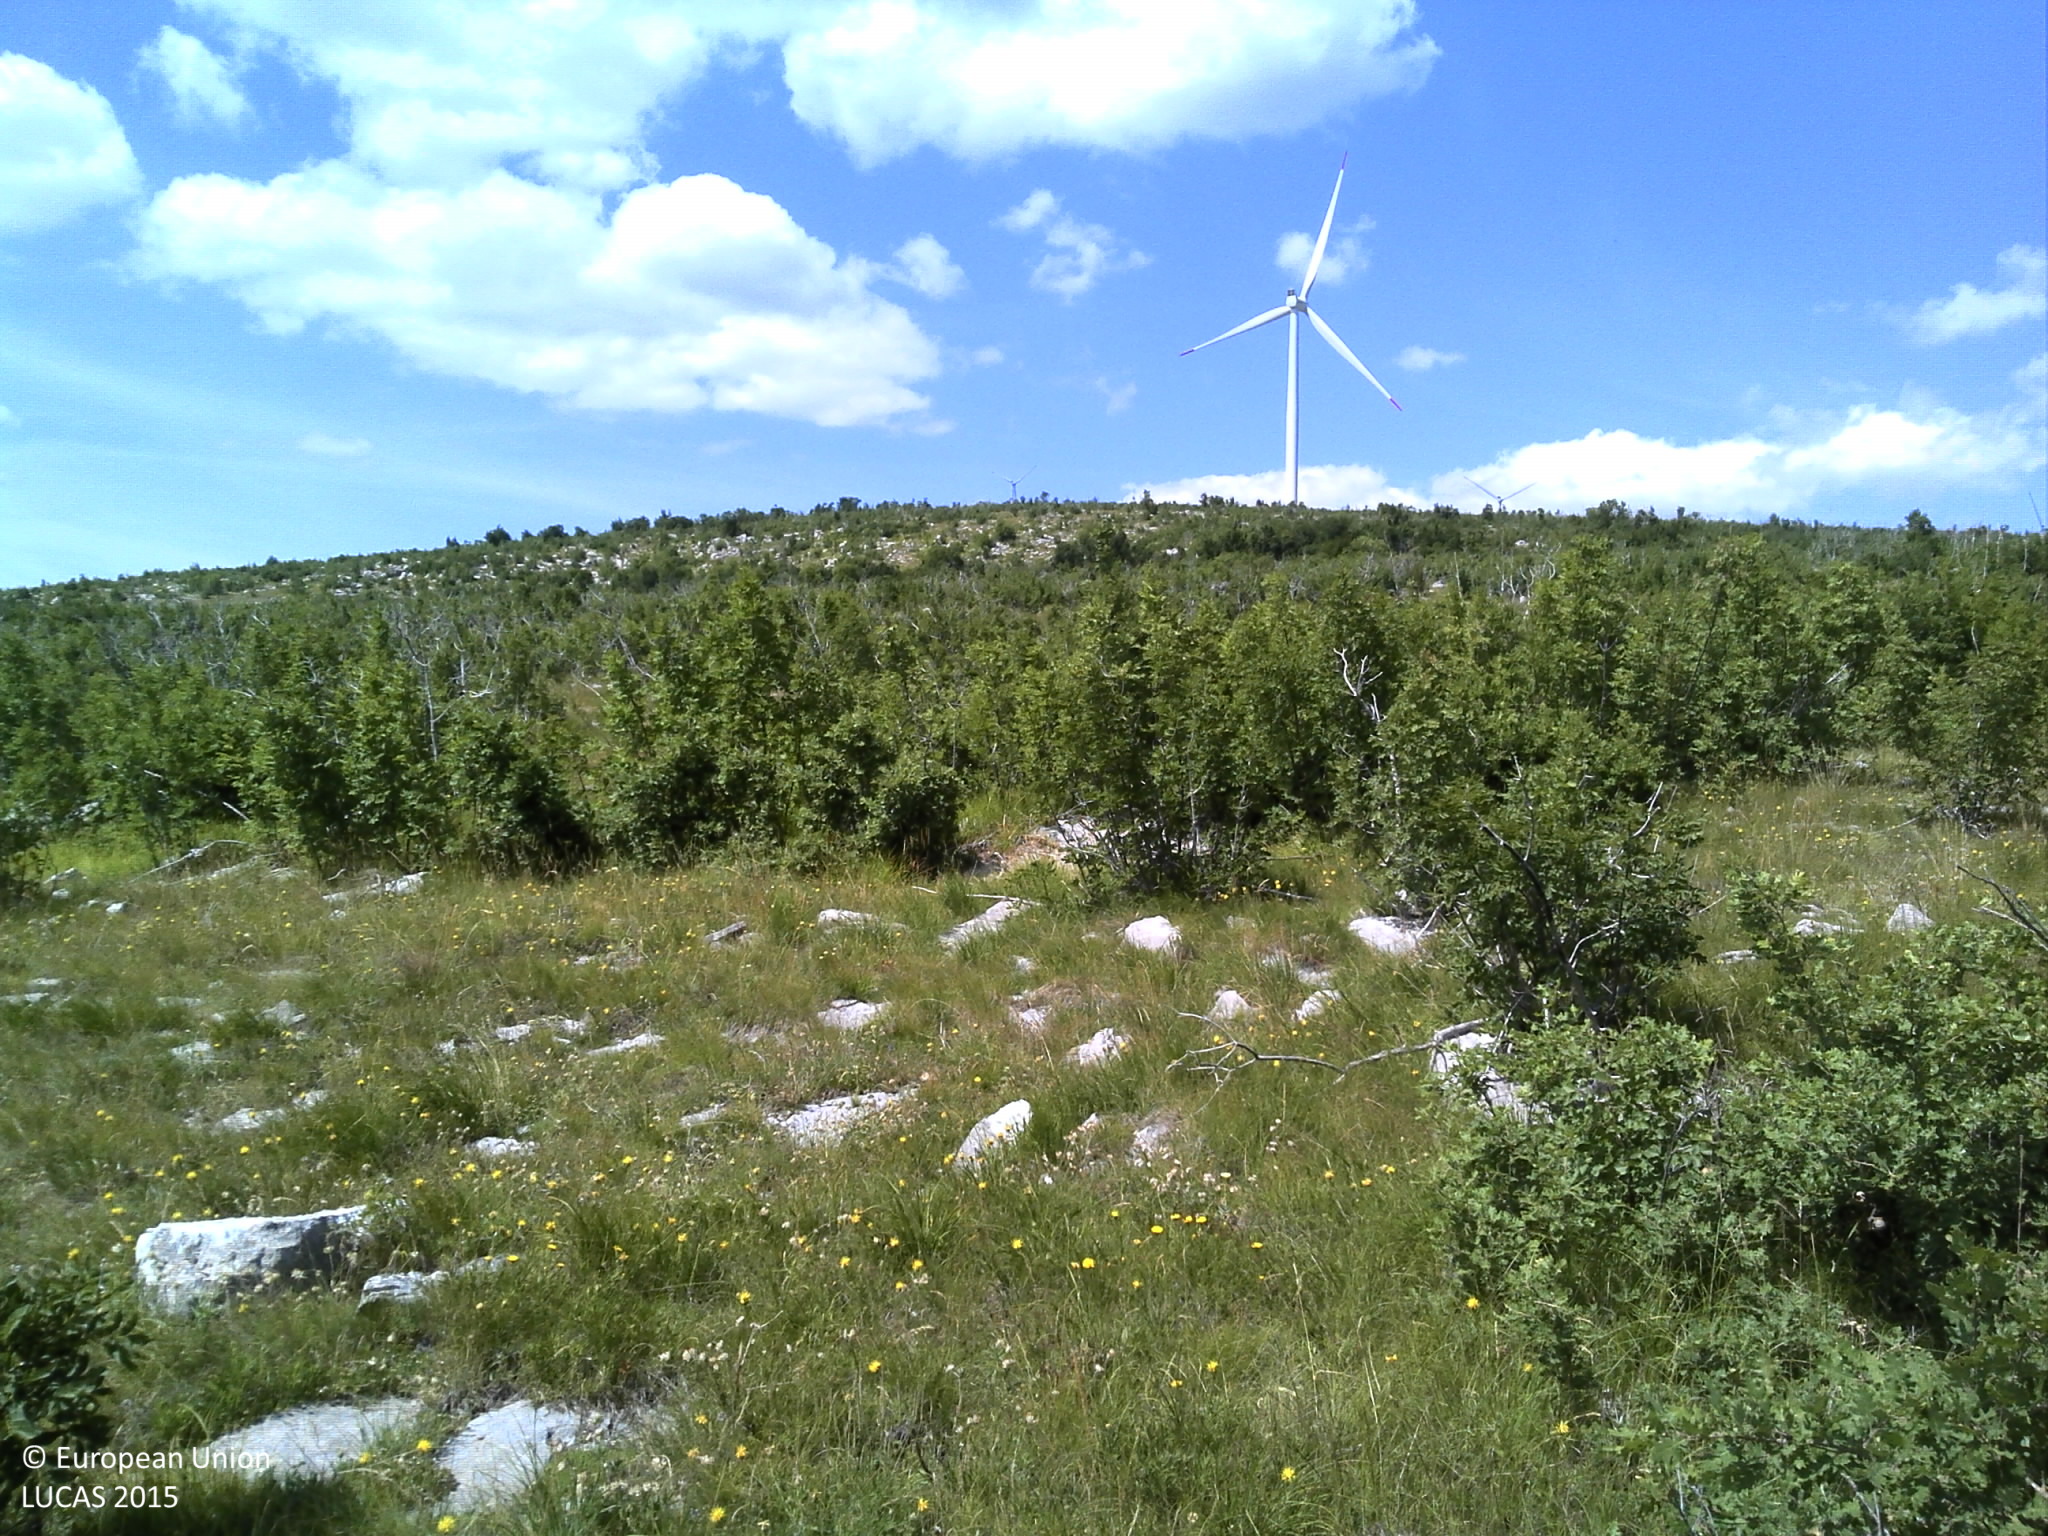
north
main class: Shrubland
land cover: Shrubland with sparse tree cover
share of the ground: > 75 %
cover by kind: shrubs 65 %, herbaceous plants 10 %, consolidated bare surface 10 %, unconsolidated bare surface 10 %, broadleaved forest trees 5 %
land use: Semi-natural and natural areas not in use
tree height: < 5 m
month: June
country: HR
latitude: 43.6127
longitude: 16.9184
